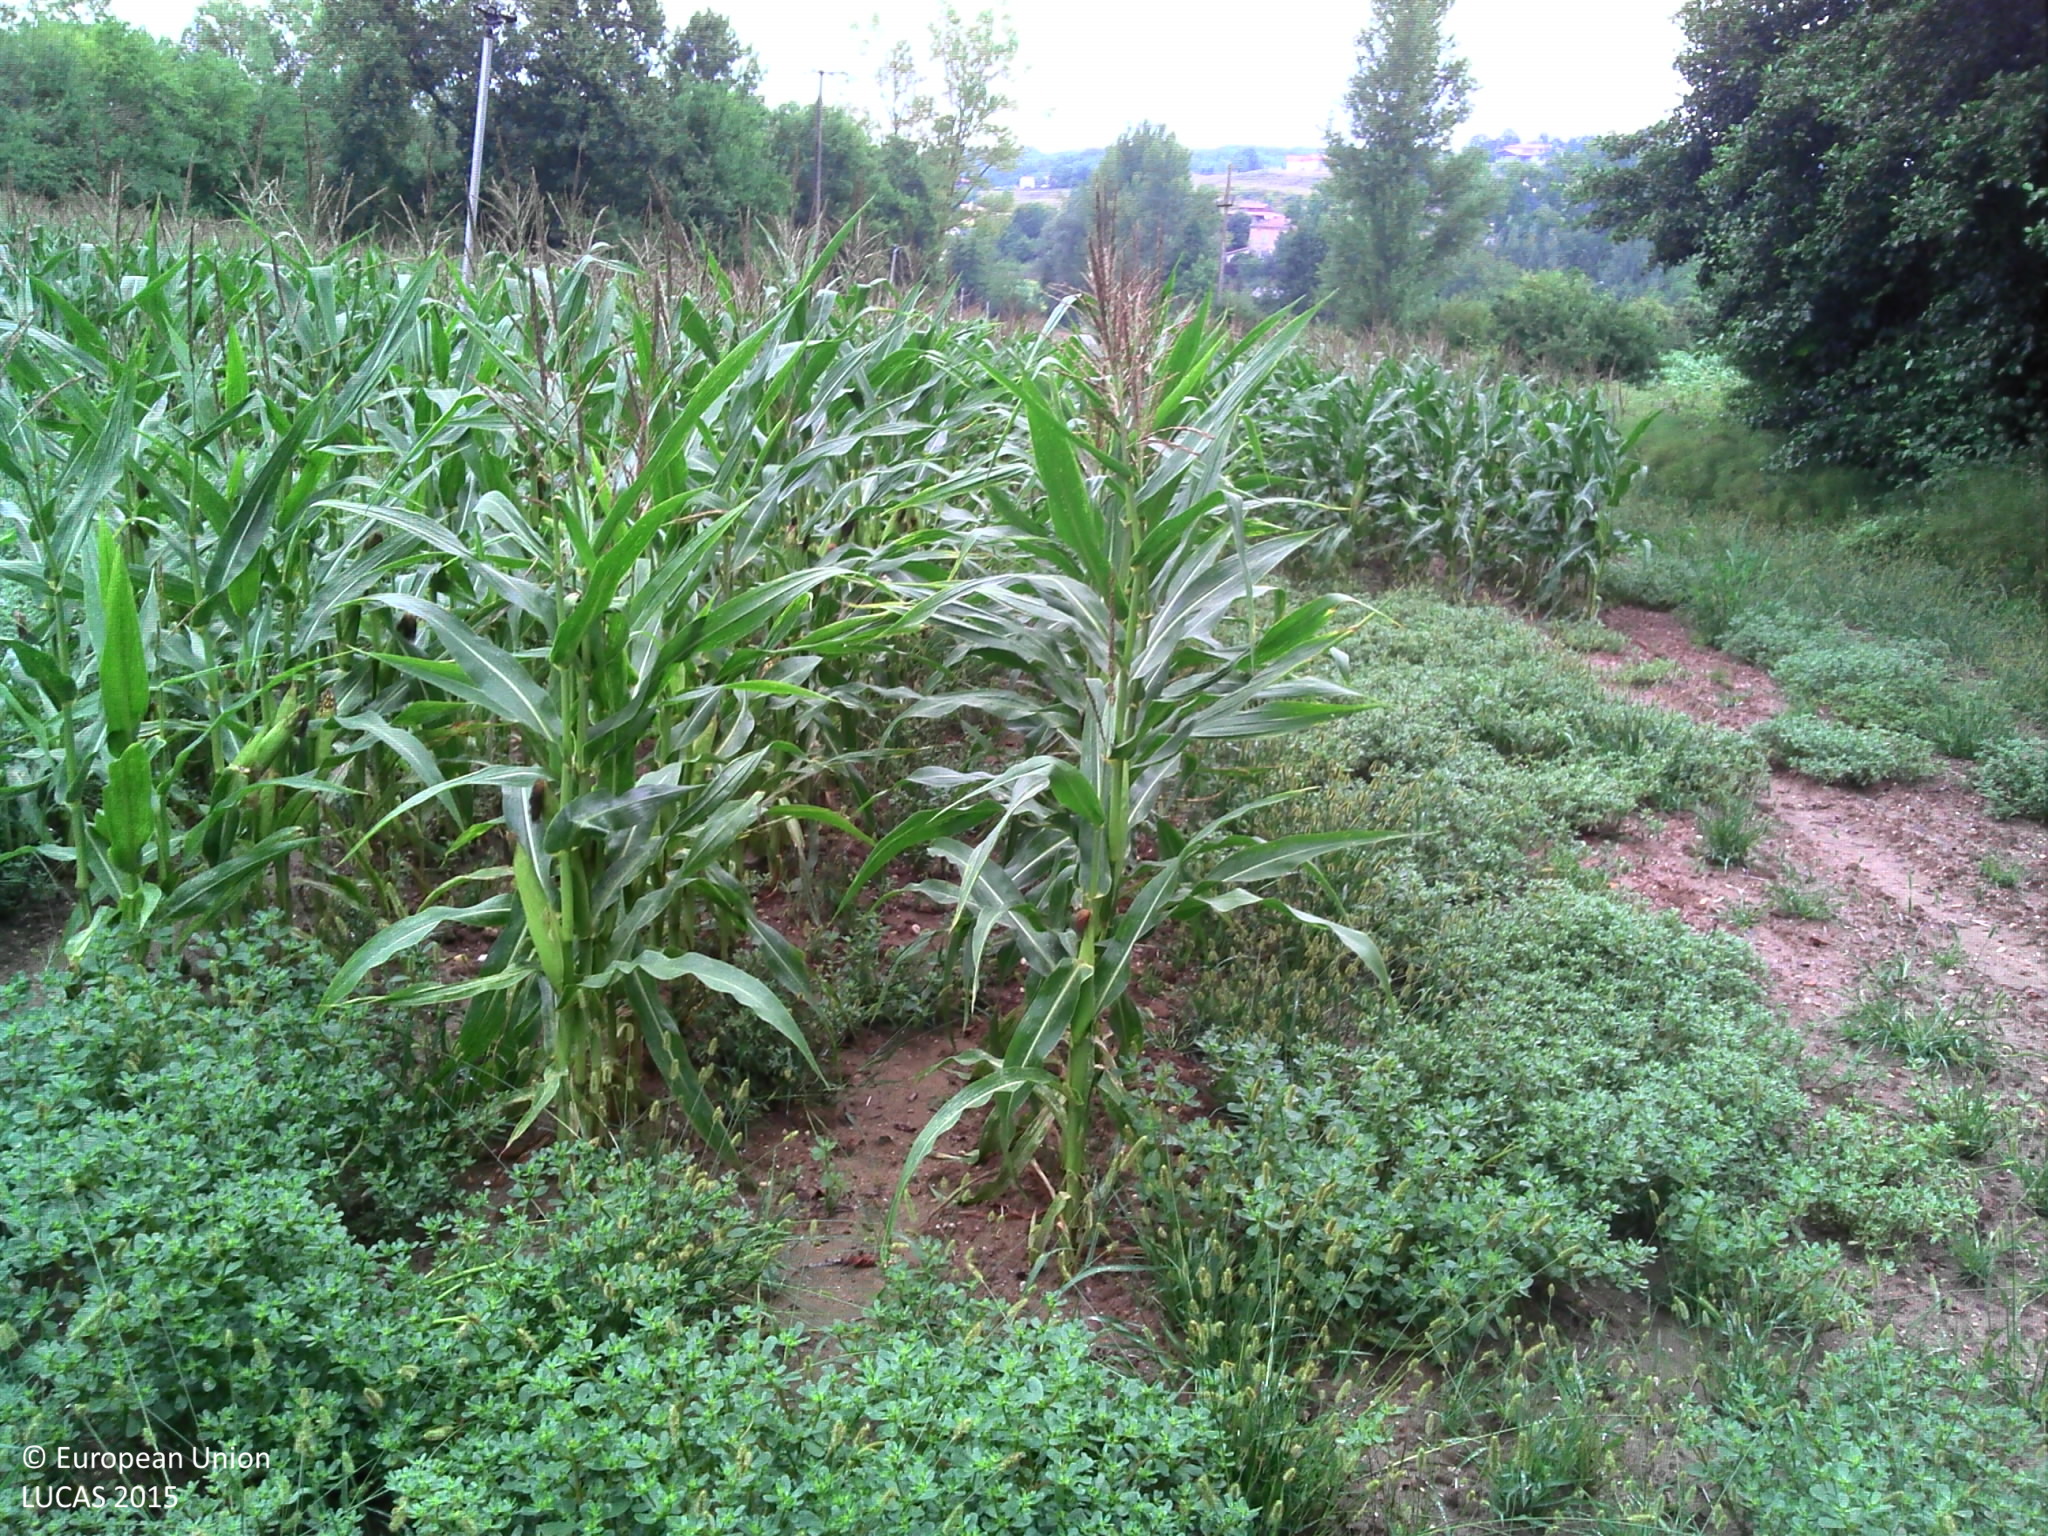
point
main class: Cropland
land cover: Maize
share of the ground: > 75 %
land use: Agriculture (excluding fallow land and kitchen gardens)
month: August
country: FR
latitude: 44.0040
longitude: 1.5326
